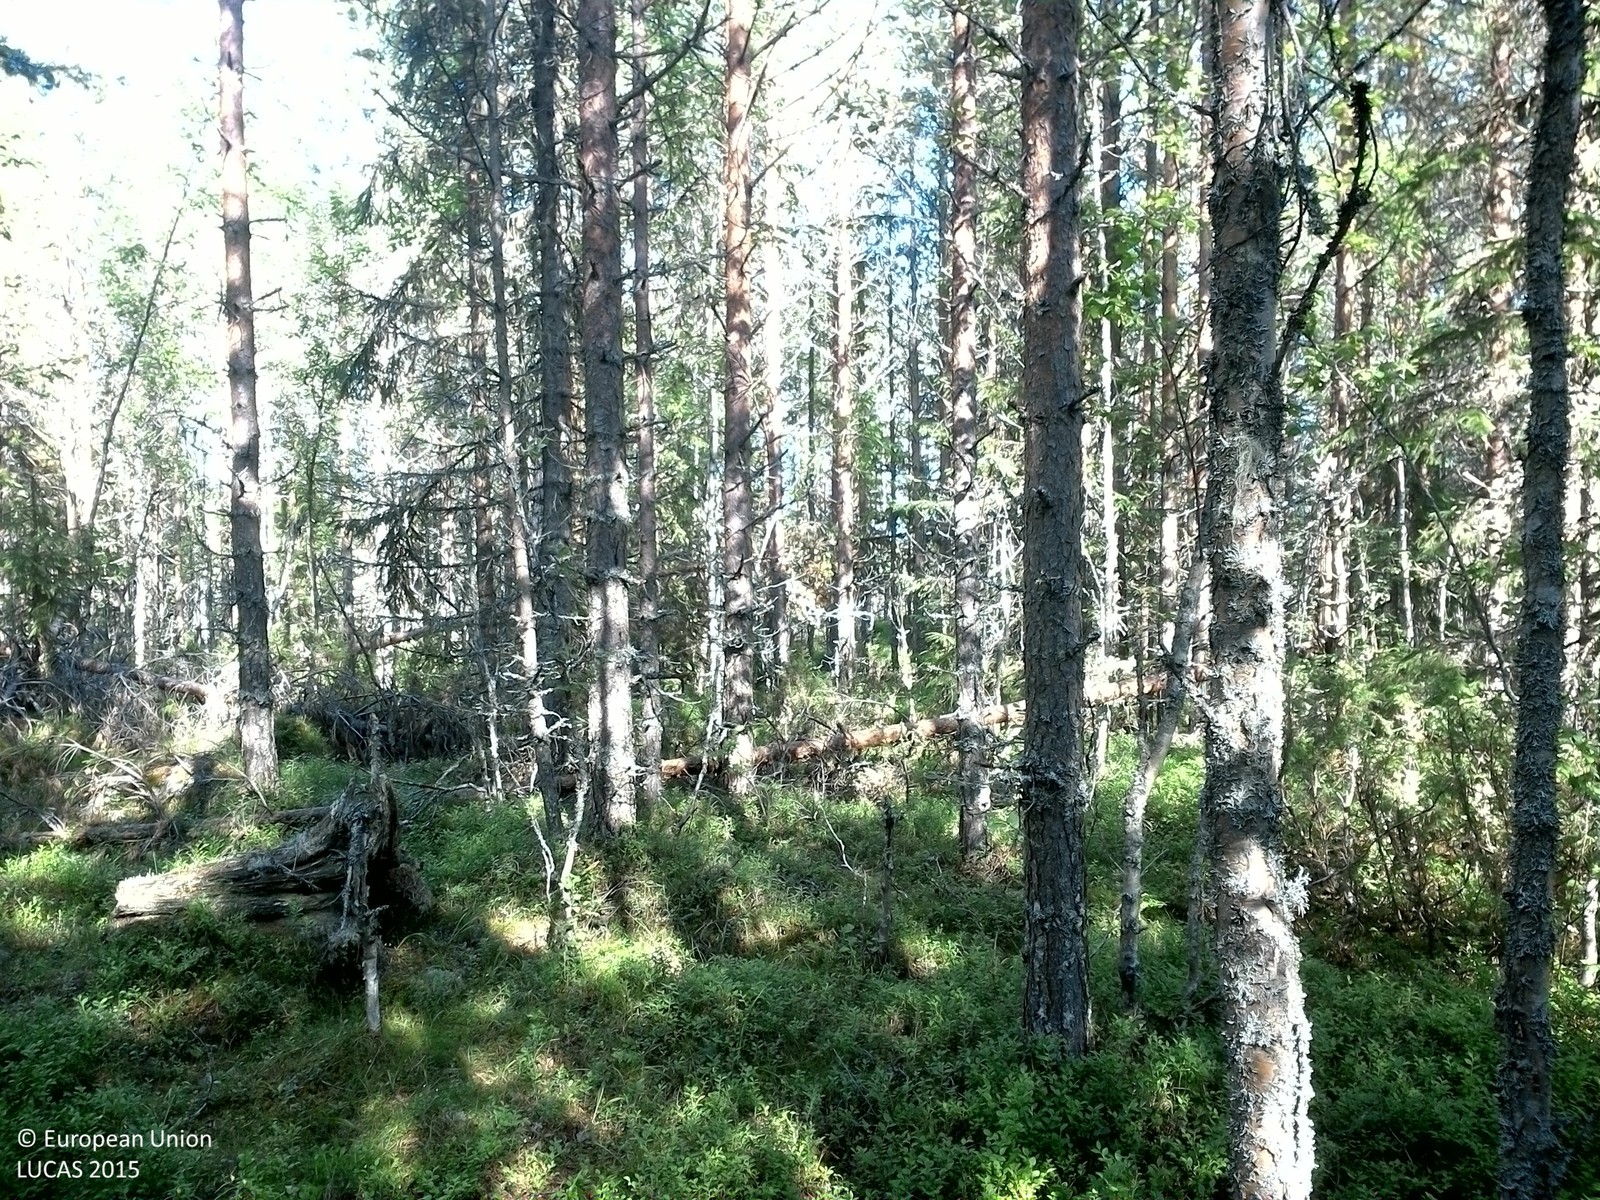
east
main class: Woodland
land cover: Pine dominated coniferous woodland
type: boreal forest
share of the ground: 50 - 75 %
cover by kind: coniferous forest trees 65 %, shrubs 25 %, broadleaved forest trees 10 %
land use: Forestry
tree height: > 5 m
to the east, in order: Pine dominated coniferous woodland; Pine dominated mixed woodland; Spruce dominated coniferous woodland; Spruce dominated mixed woodland
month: July
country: SE
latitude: 62.7103
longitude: 17.2317
